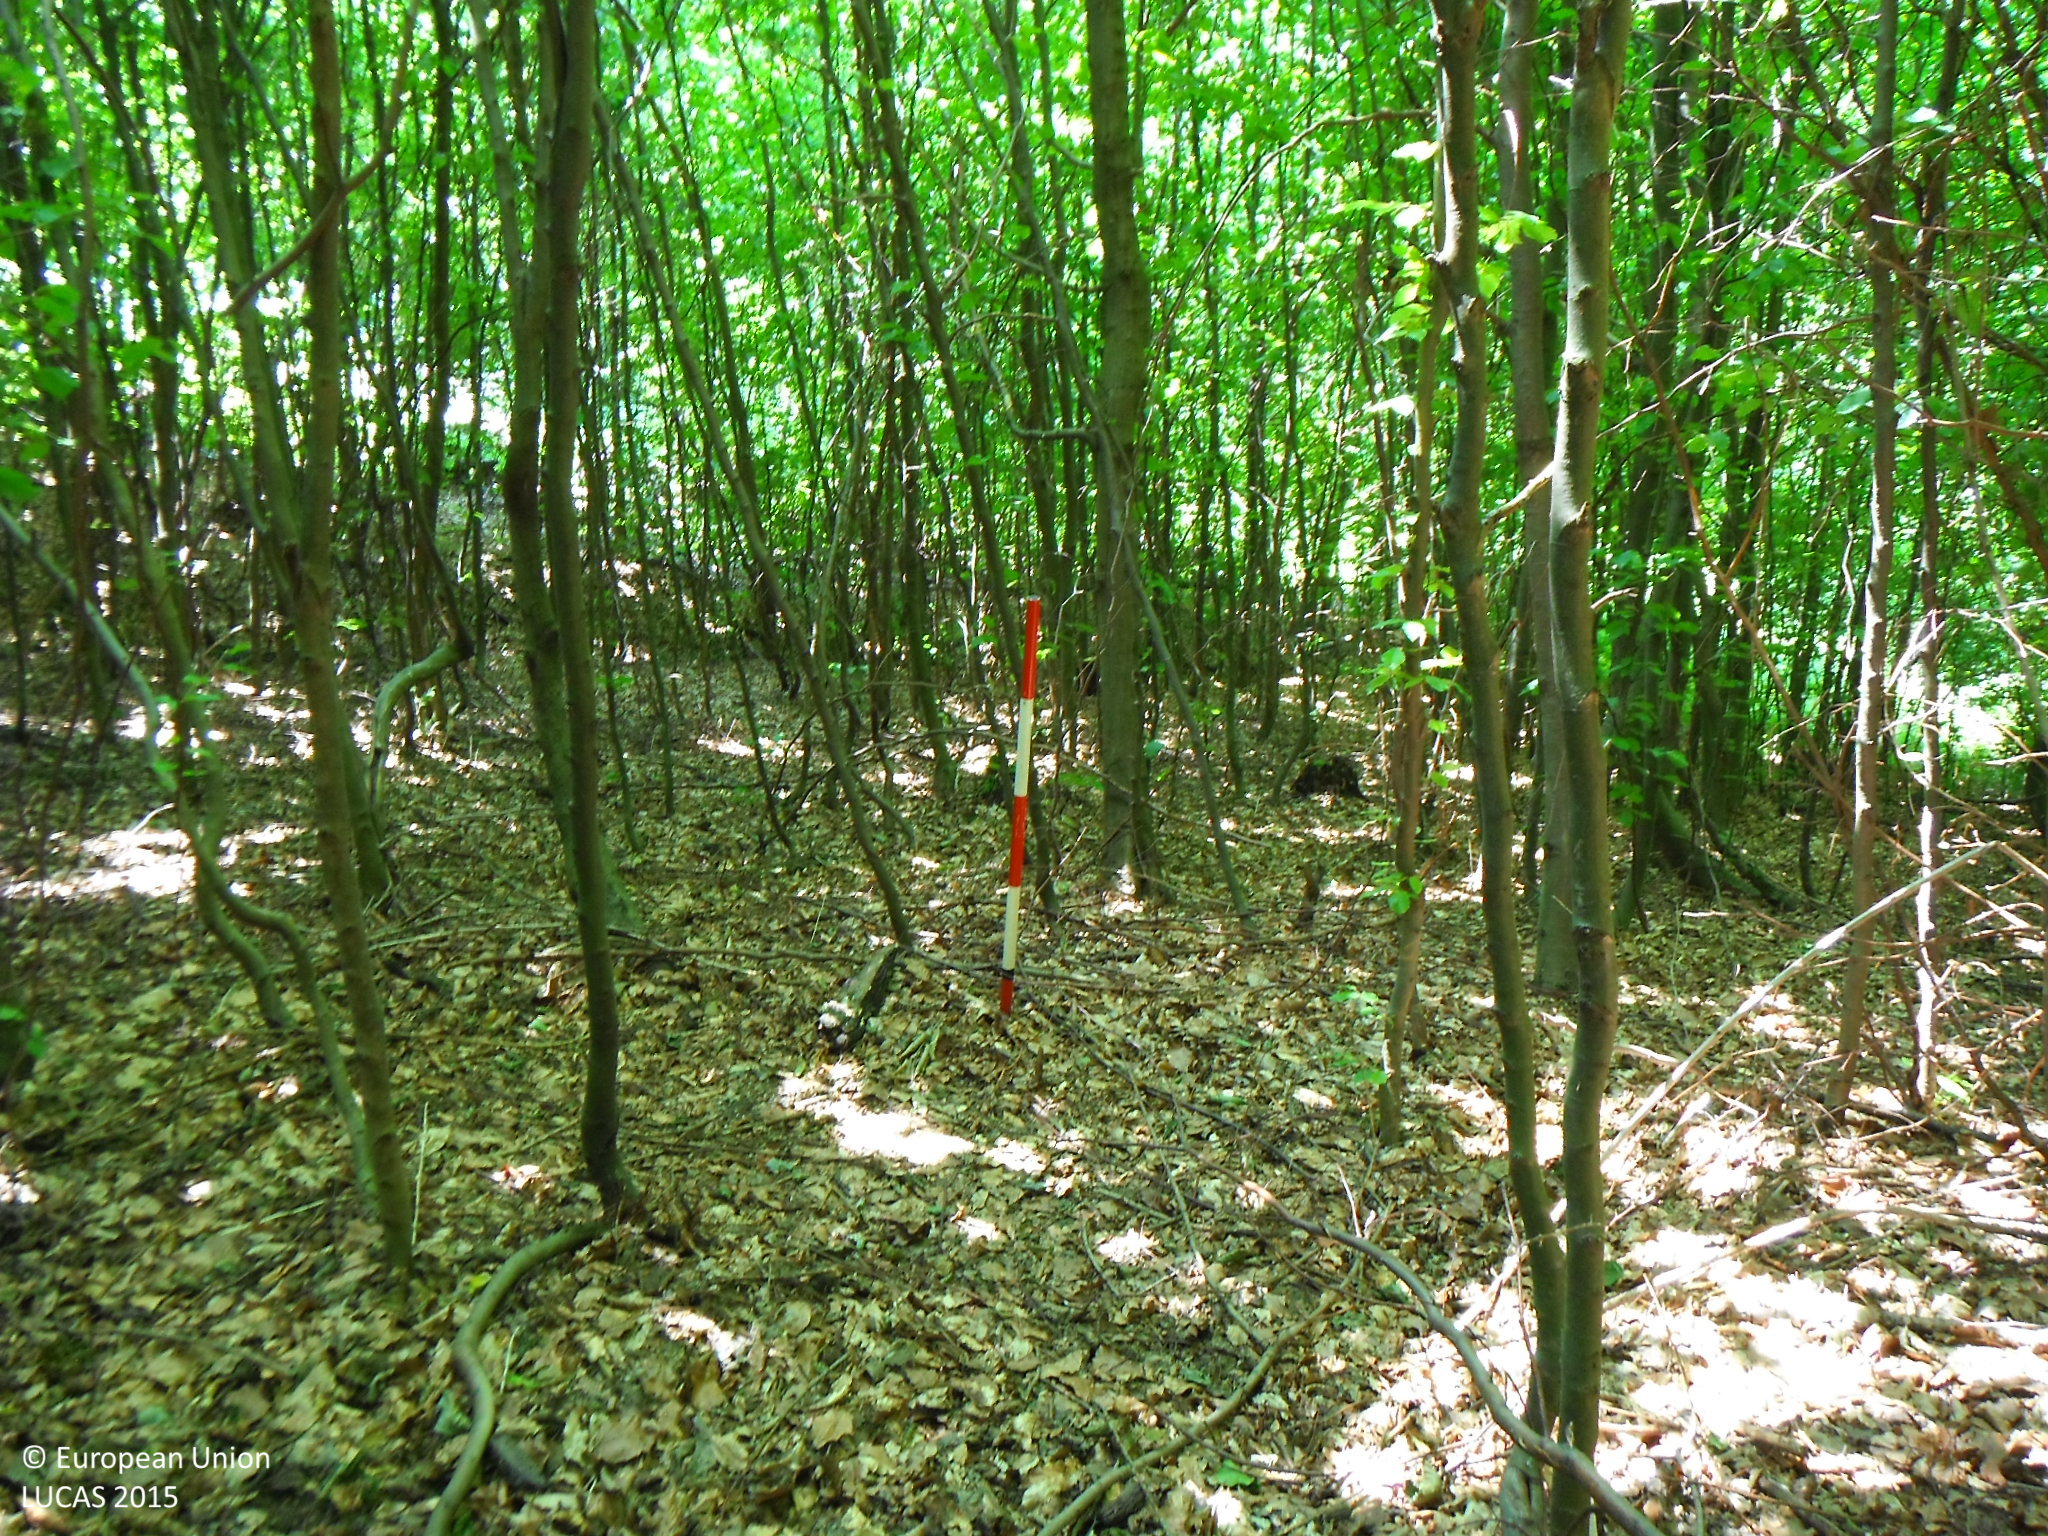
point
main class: Woodland
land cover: Broadleaved woodland
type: beech forest
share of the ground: > 75 %
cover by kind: broadleaved forest trees 100 %
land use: Forestry
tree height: > 5 m
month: July
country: SK
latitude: 49.3526
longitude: 21.4332
